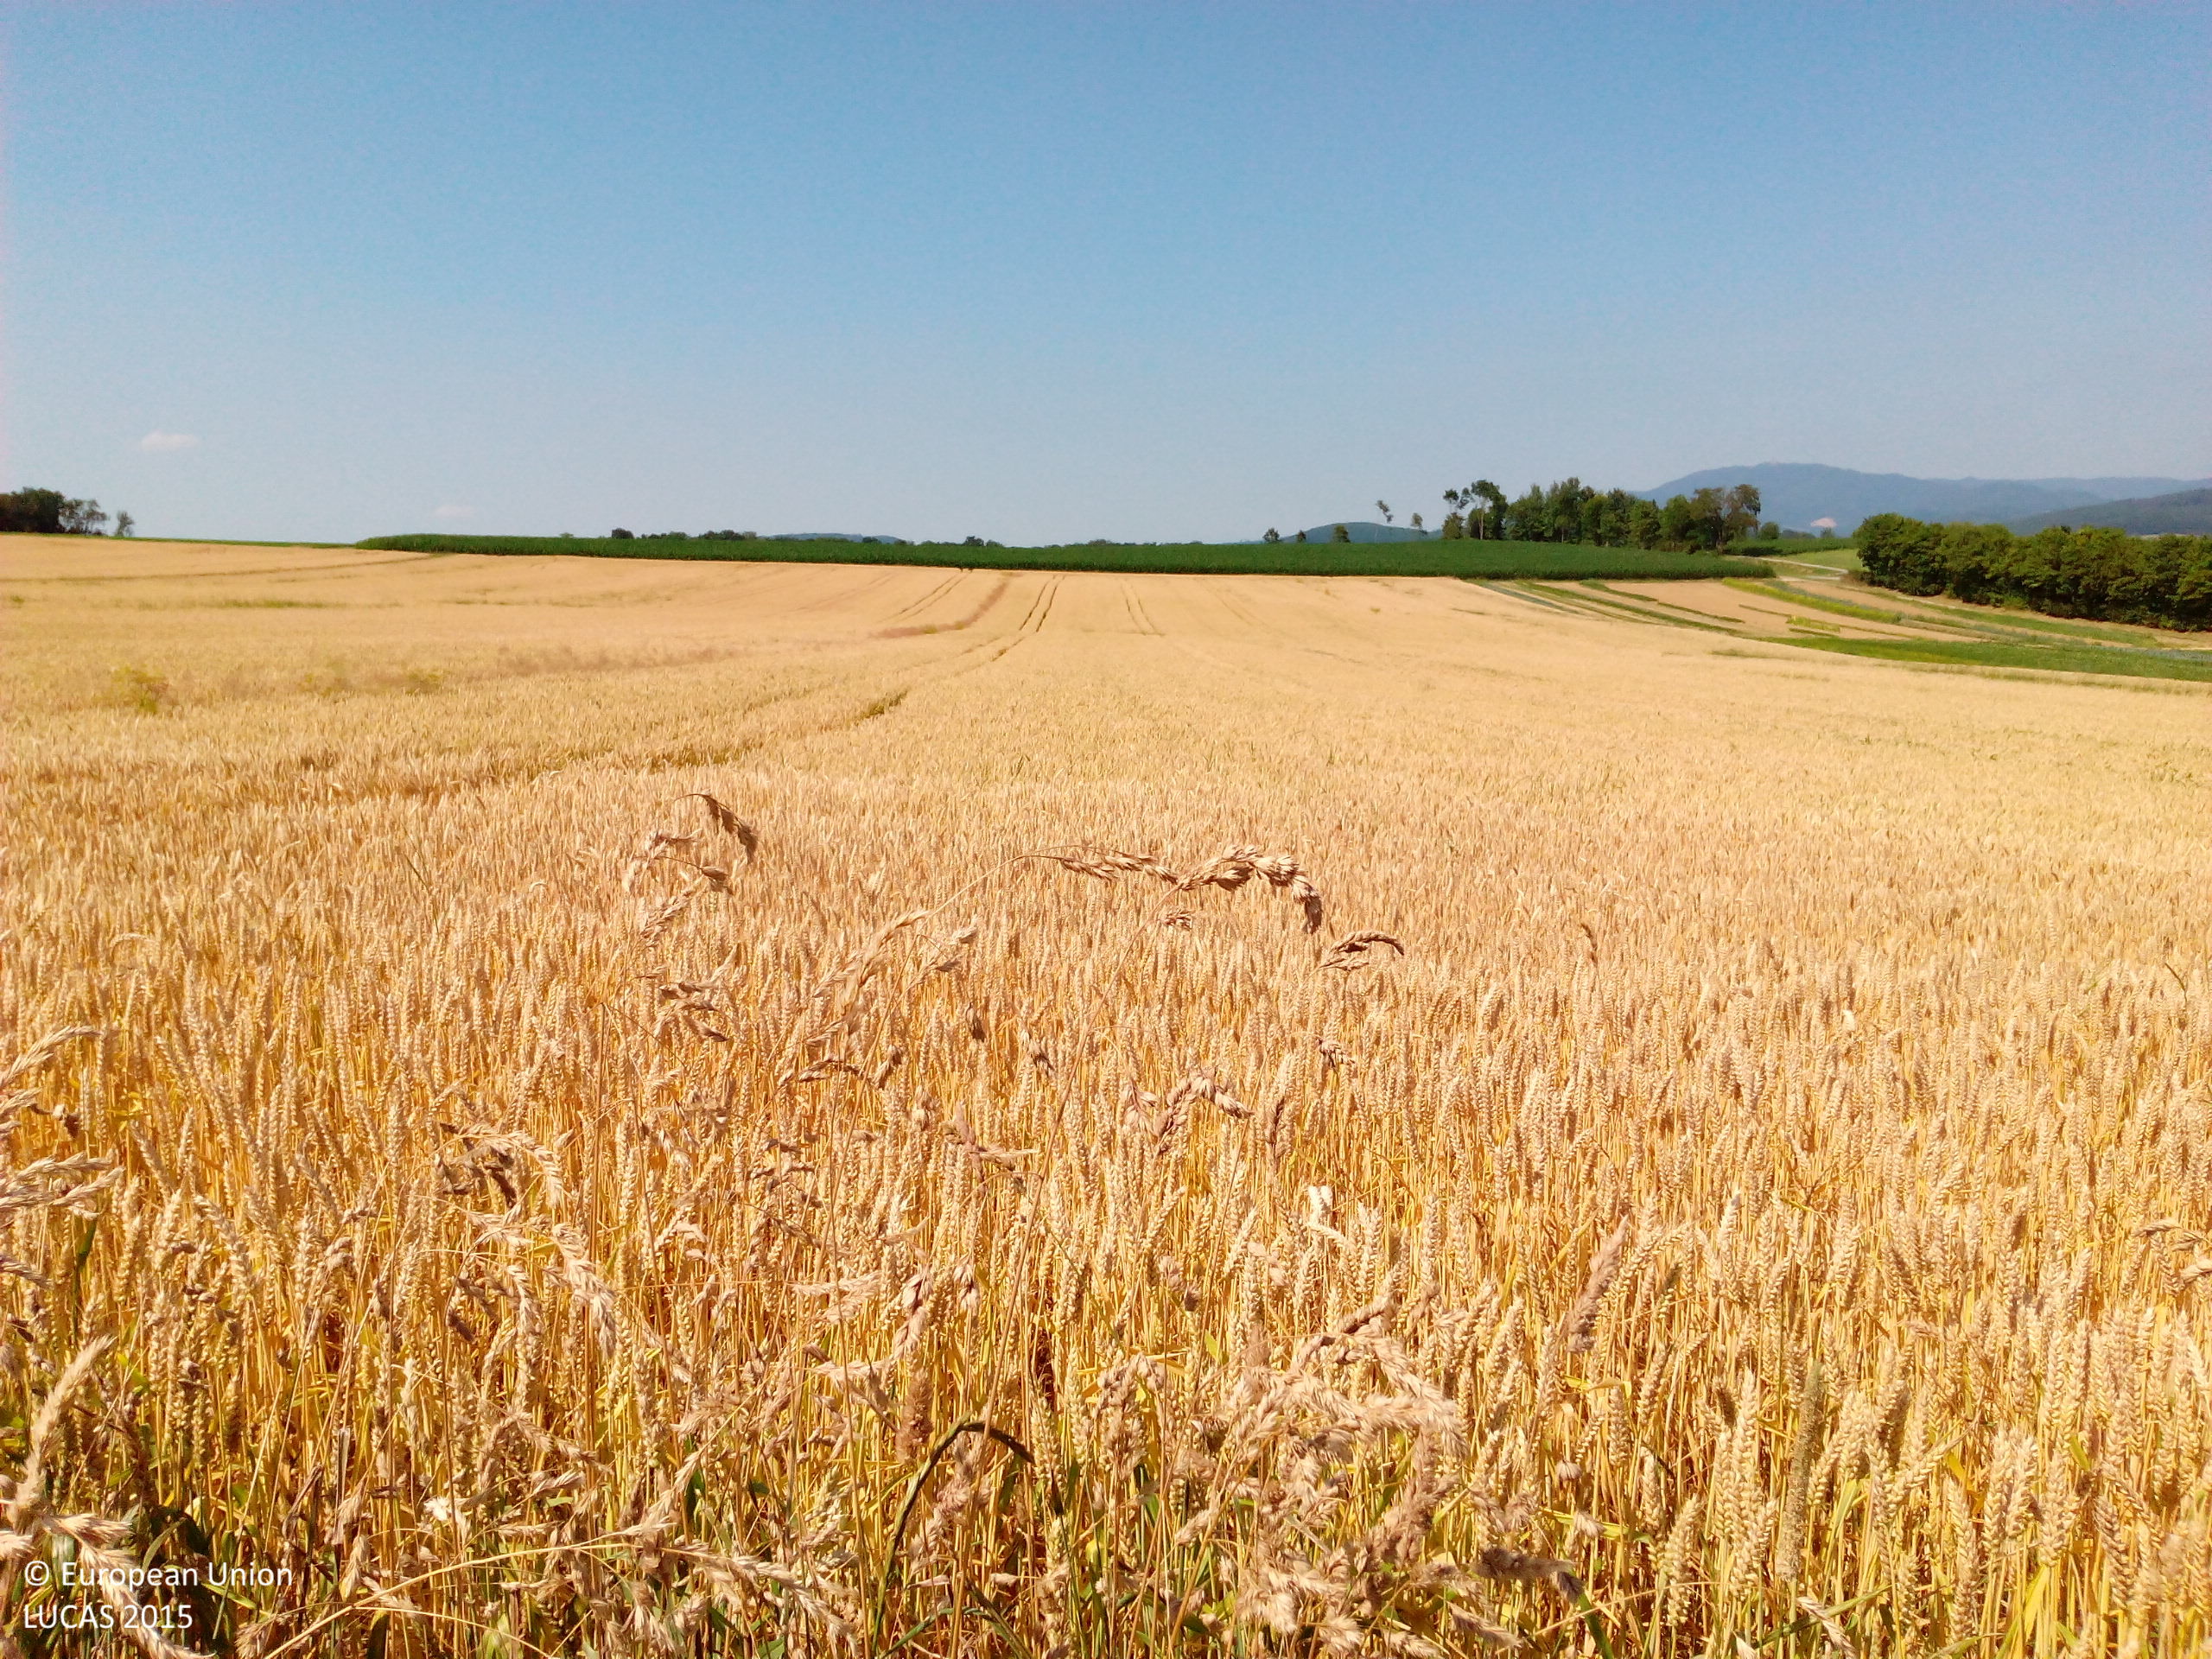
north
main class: Cropland
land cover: Common wheat
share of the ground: > 75 %
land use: Agriculture (excluding fallow land and kitchen gardens)
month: July
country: DE
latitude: 47.6577
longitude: 7.6181
